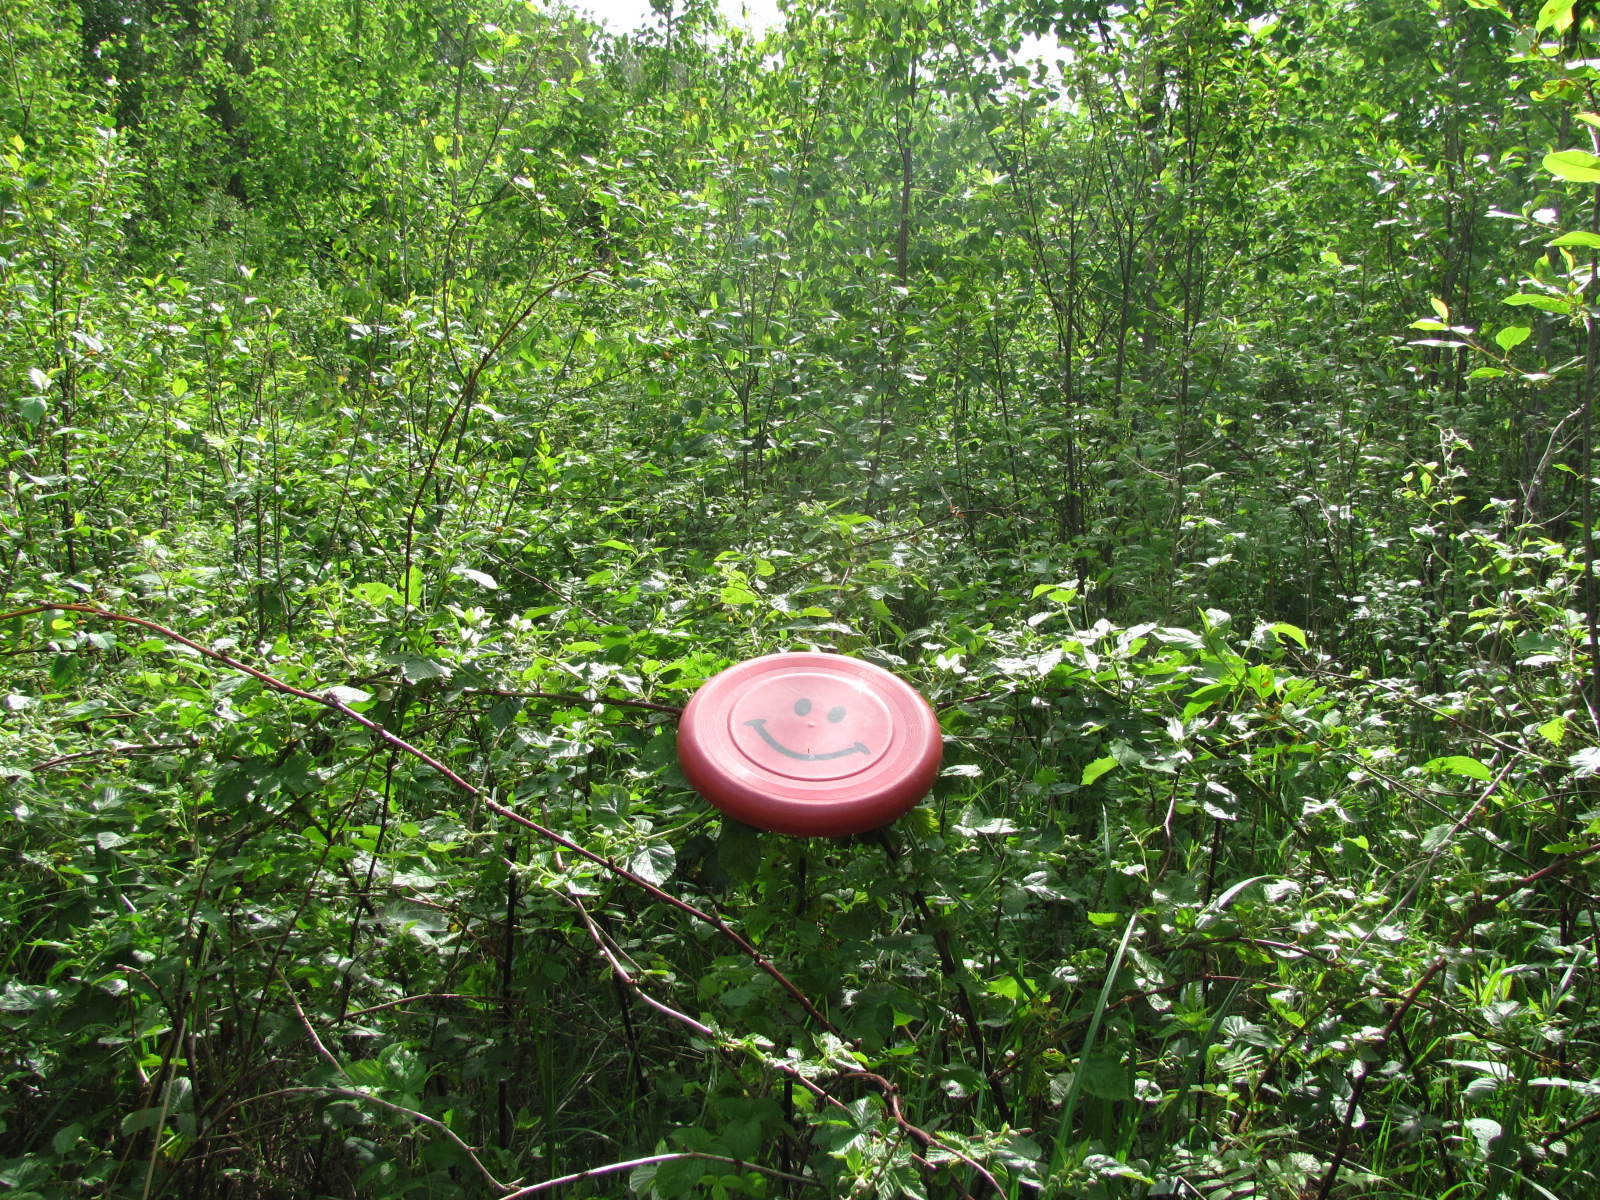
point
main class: Woodland
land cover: Broadleaved woodland
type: non-riverine alder, birch or aspen forest
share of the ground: 50 - 75 %
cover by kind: broadleaved forest trees 70 %, shrubs 30 %
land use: Forestry
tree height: < 5 m
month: June
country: LV
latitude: 56.7040
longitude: 23.9167
